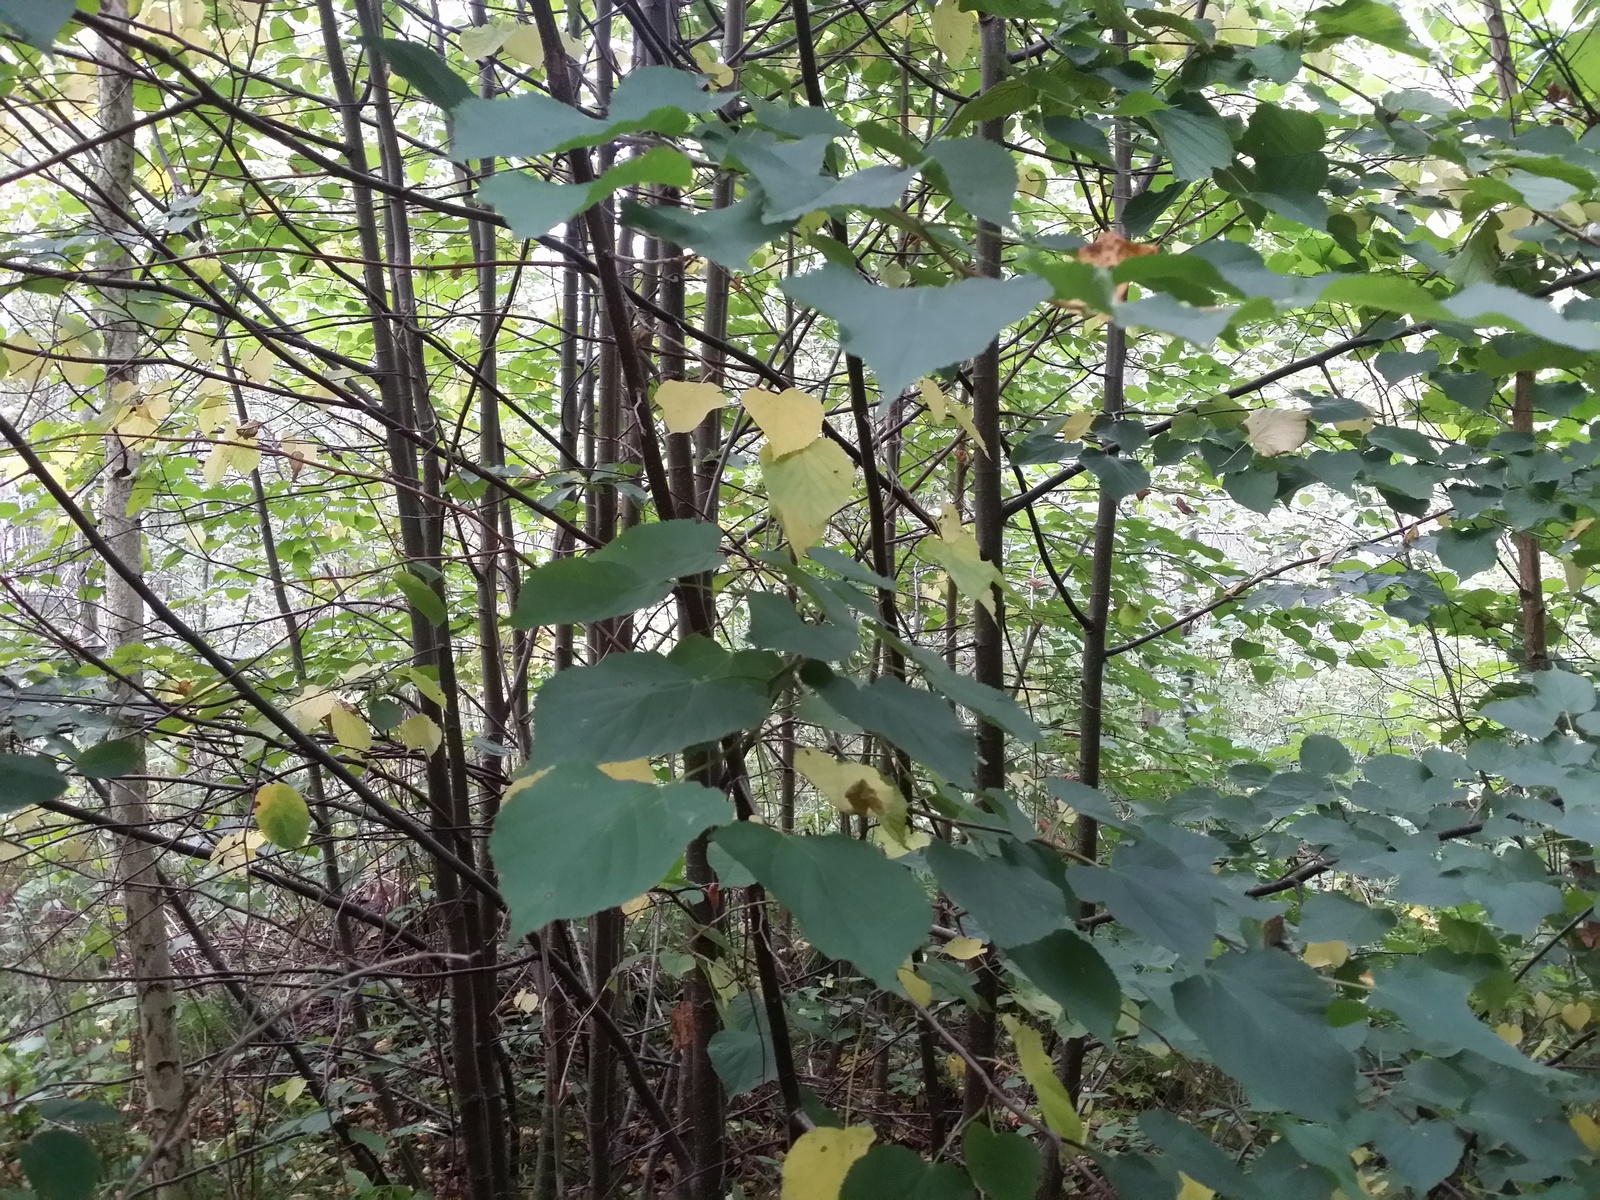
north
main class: Woodland
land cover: Broadleaved woodland
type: non-riverine alder, birch or aspen forest
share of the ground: > 75 %
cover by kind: broadleaved forest trees 85 %, herbaceous plants 10 %, shrubs 5 %
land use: Forestry
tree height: > 5 m
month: August
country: LV
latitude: 56.9560
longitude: 27.1515
